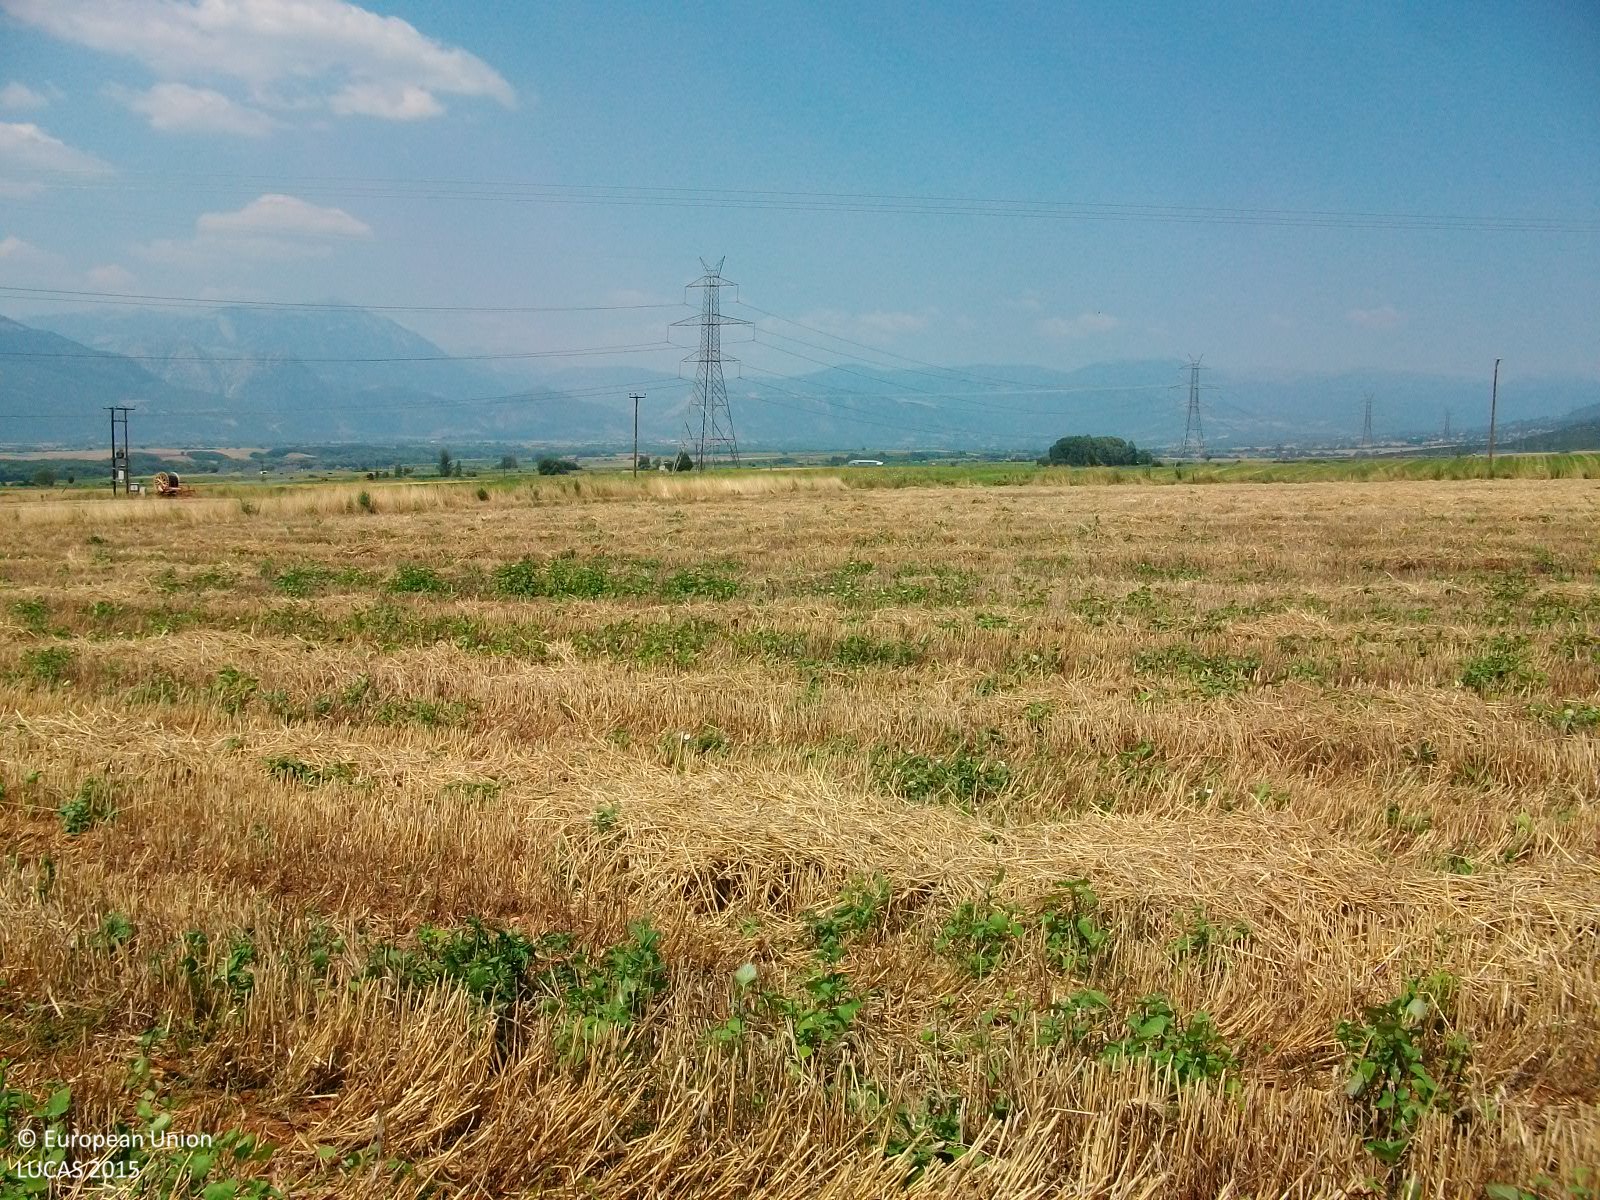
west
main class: Cropland
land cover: Durum wheat
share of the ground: > 75 %
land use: Agriculture (excluding fallow land and kitchen gardens)
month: July
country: GR
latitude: 38.6902
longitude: 22.5449
